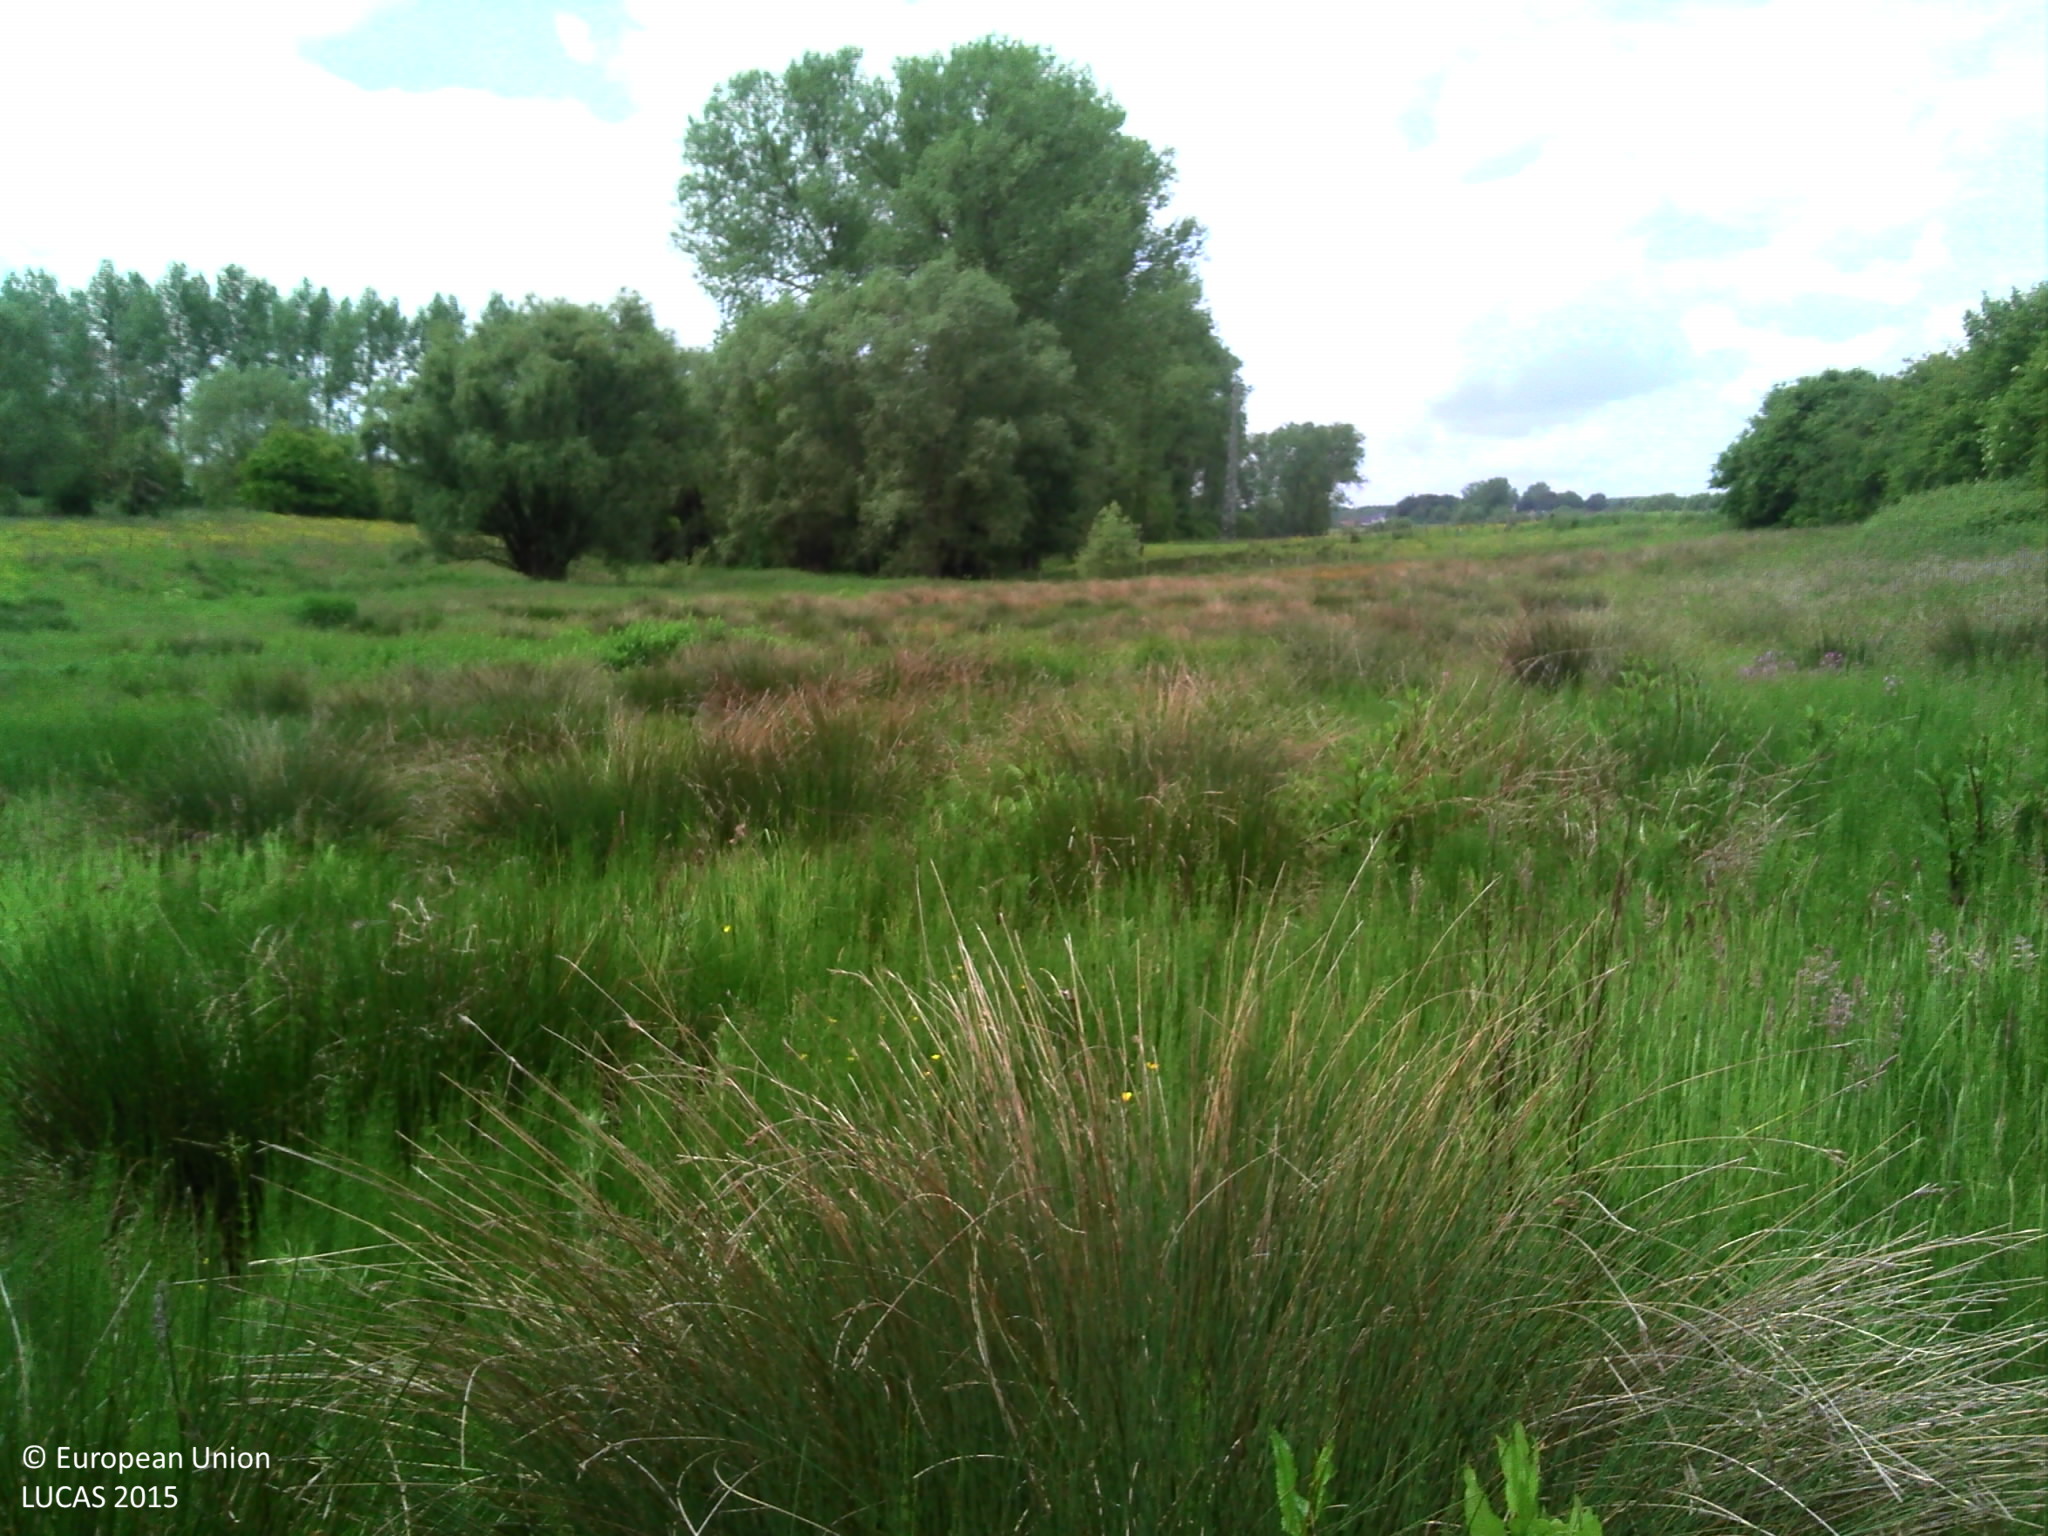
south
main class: Grassland
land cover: Grassland without tree/shrub cover
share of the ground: > 75 %
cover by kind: herbaceous plants 100 %
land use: Agriculture (excluding fallow land and kitchen gardens)
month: June
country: BE
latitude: 50.8041
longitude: 4.0488
